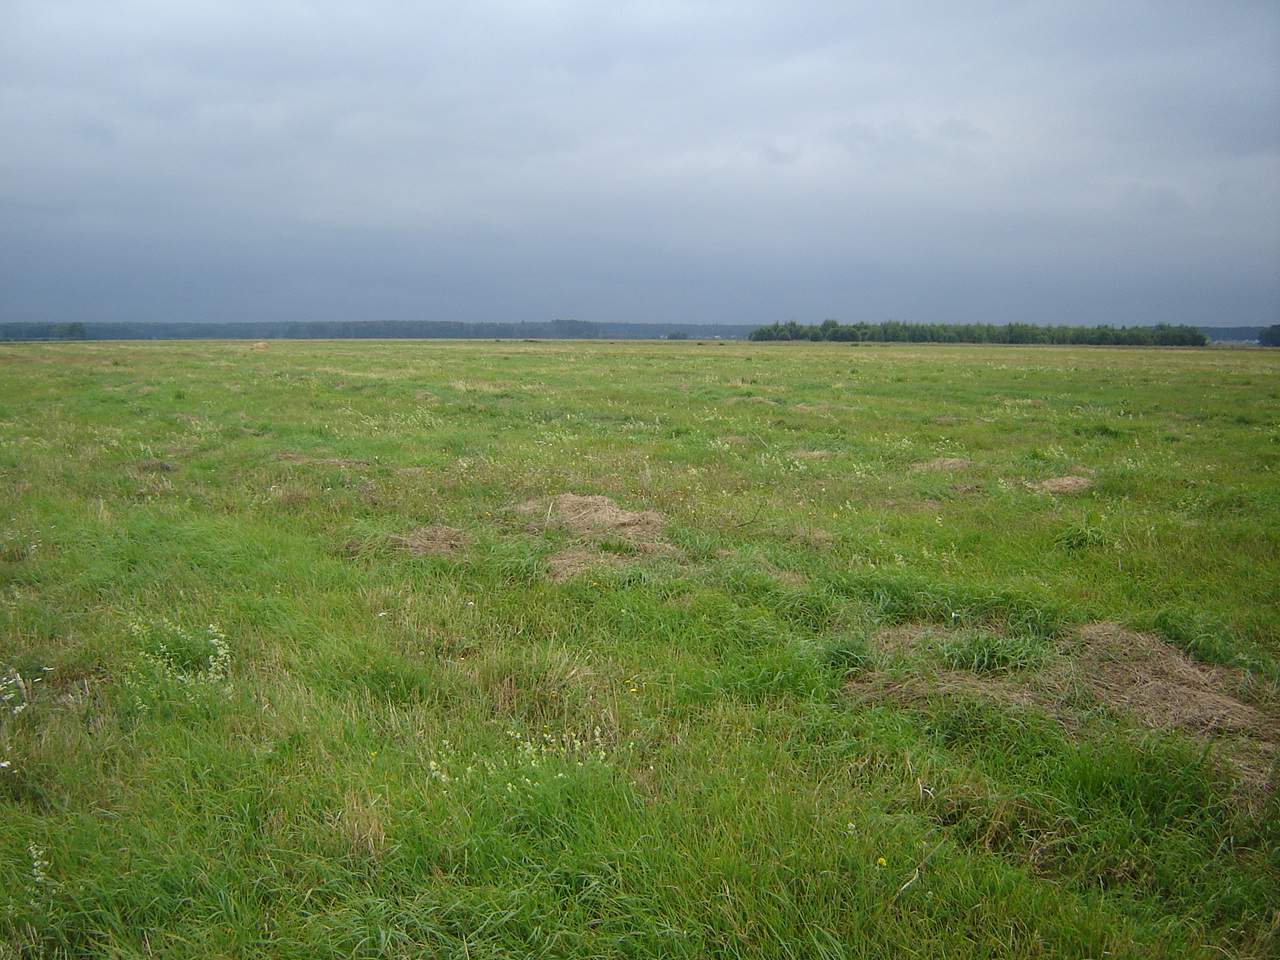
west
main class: Grassland
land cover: Grassland without tree/shrub cover
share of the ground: > 75 %
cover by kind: herbaceous plants 100 %
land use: Agriculture (excluding fallow land and kitchen gardens)
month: September
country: LT
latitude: 54.4006
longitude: 24.8531
